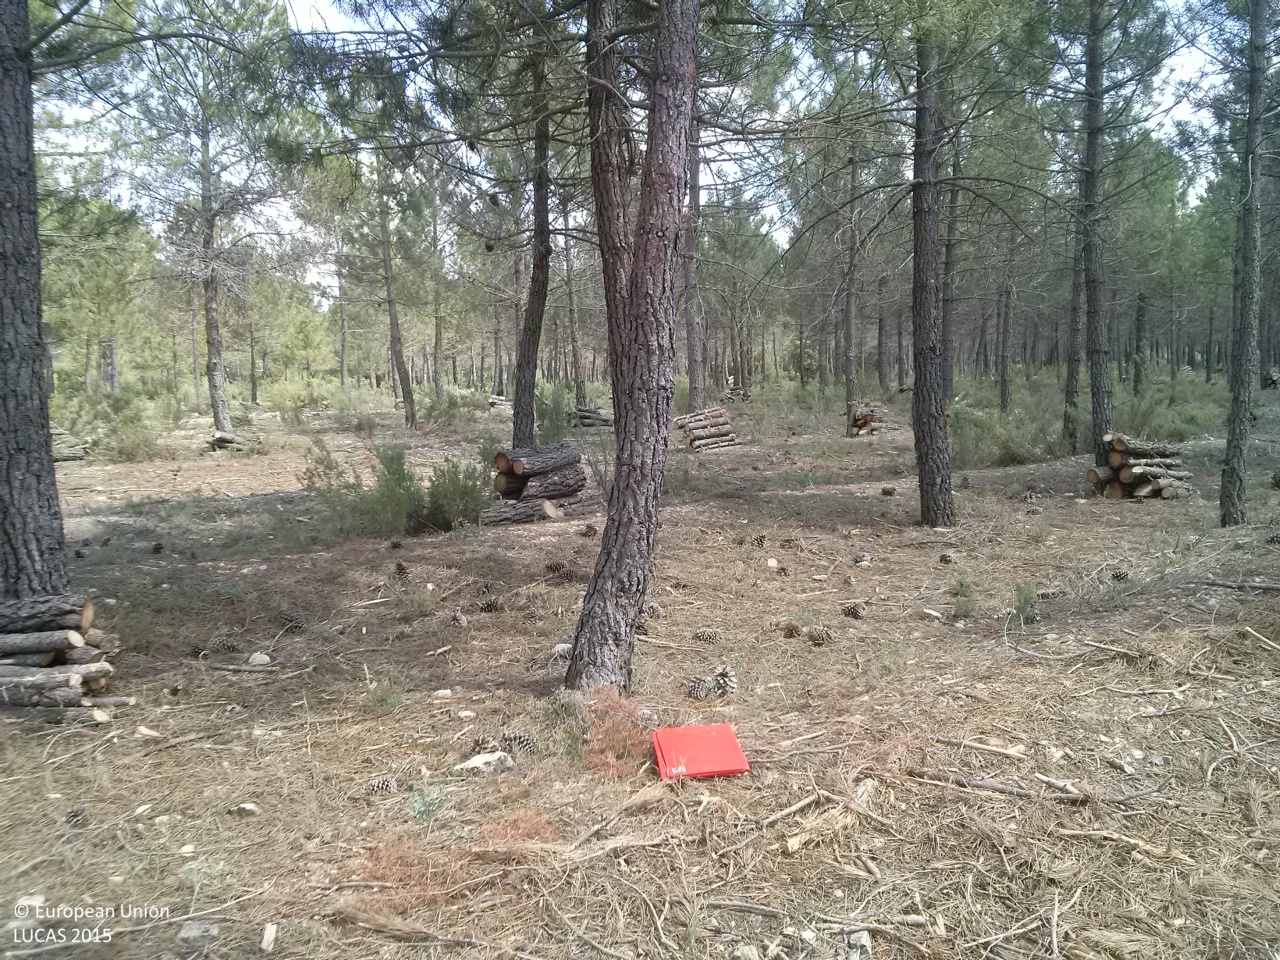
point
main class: Woodland
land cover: Pine dominated coniferous woodland
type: coniferous forest of the mediterranean region
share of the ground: 25 - 50 %
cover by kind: coniferous forest trees 50 %, herbaceous plants 20 %, unconsolidated bare surface 20 %, shrubs 10 %
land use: Forestry
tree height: > 5 m
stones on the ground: 25 - 50 %
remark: Clear cut
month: June
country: ES
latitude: 39.6770
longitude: -1.6776
